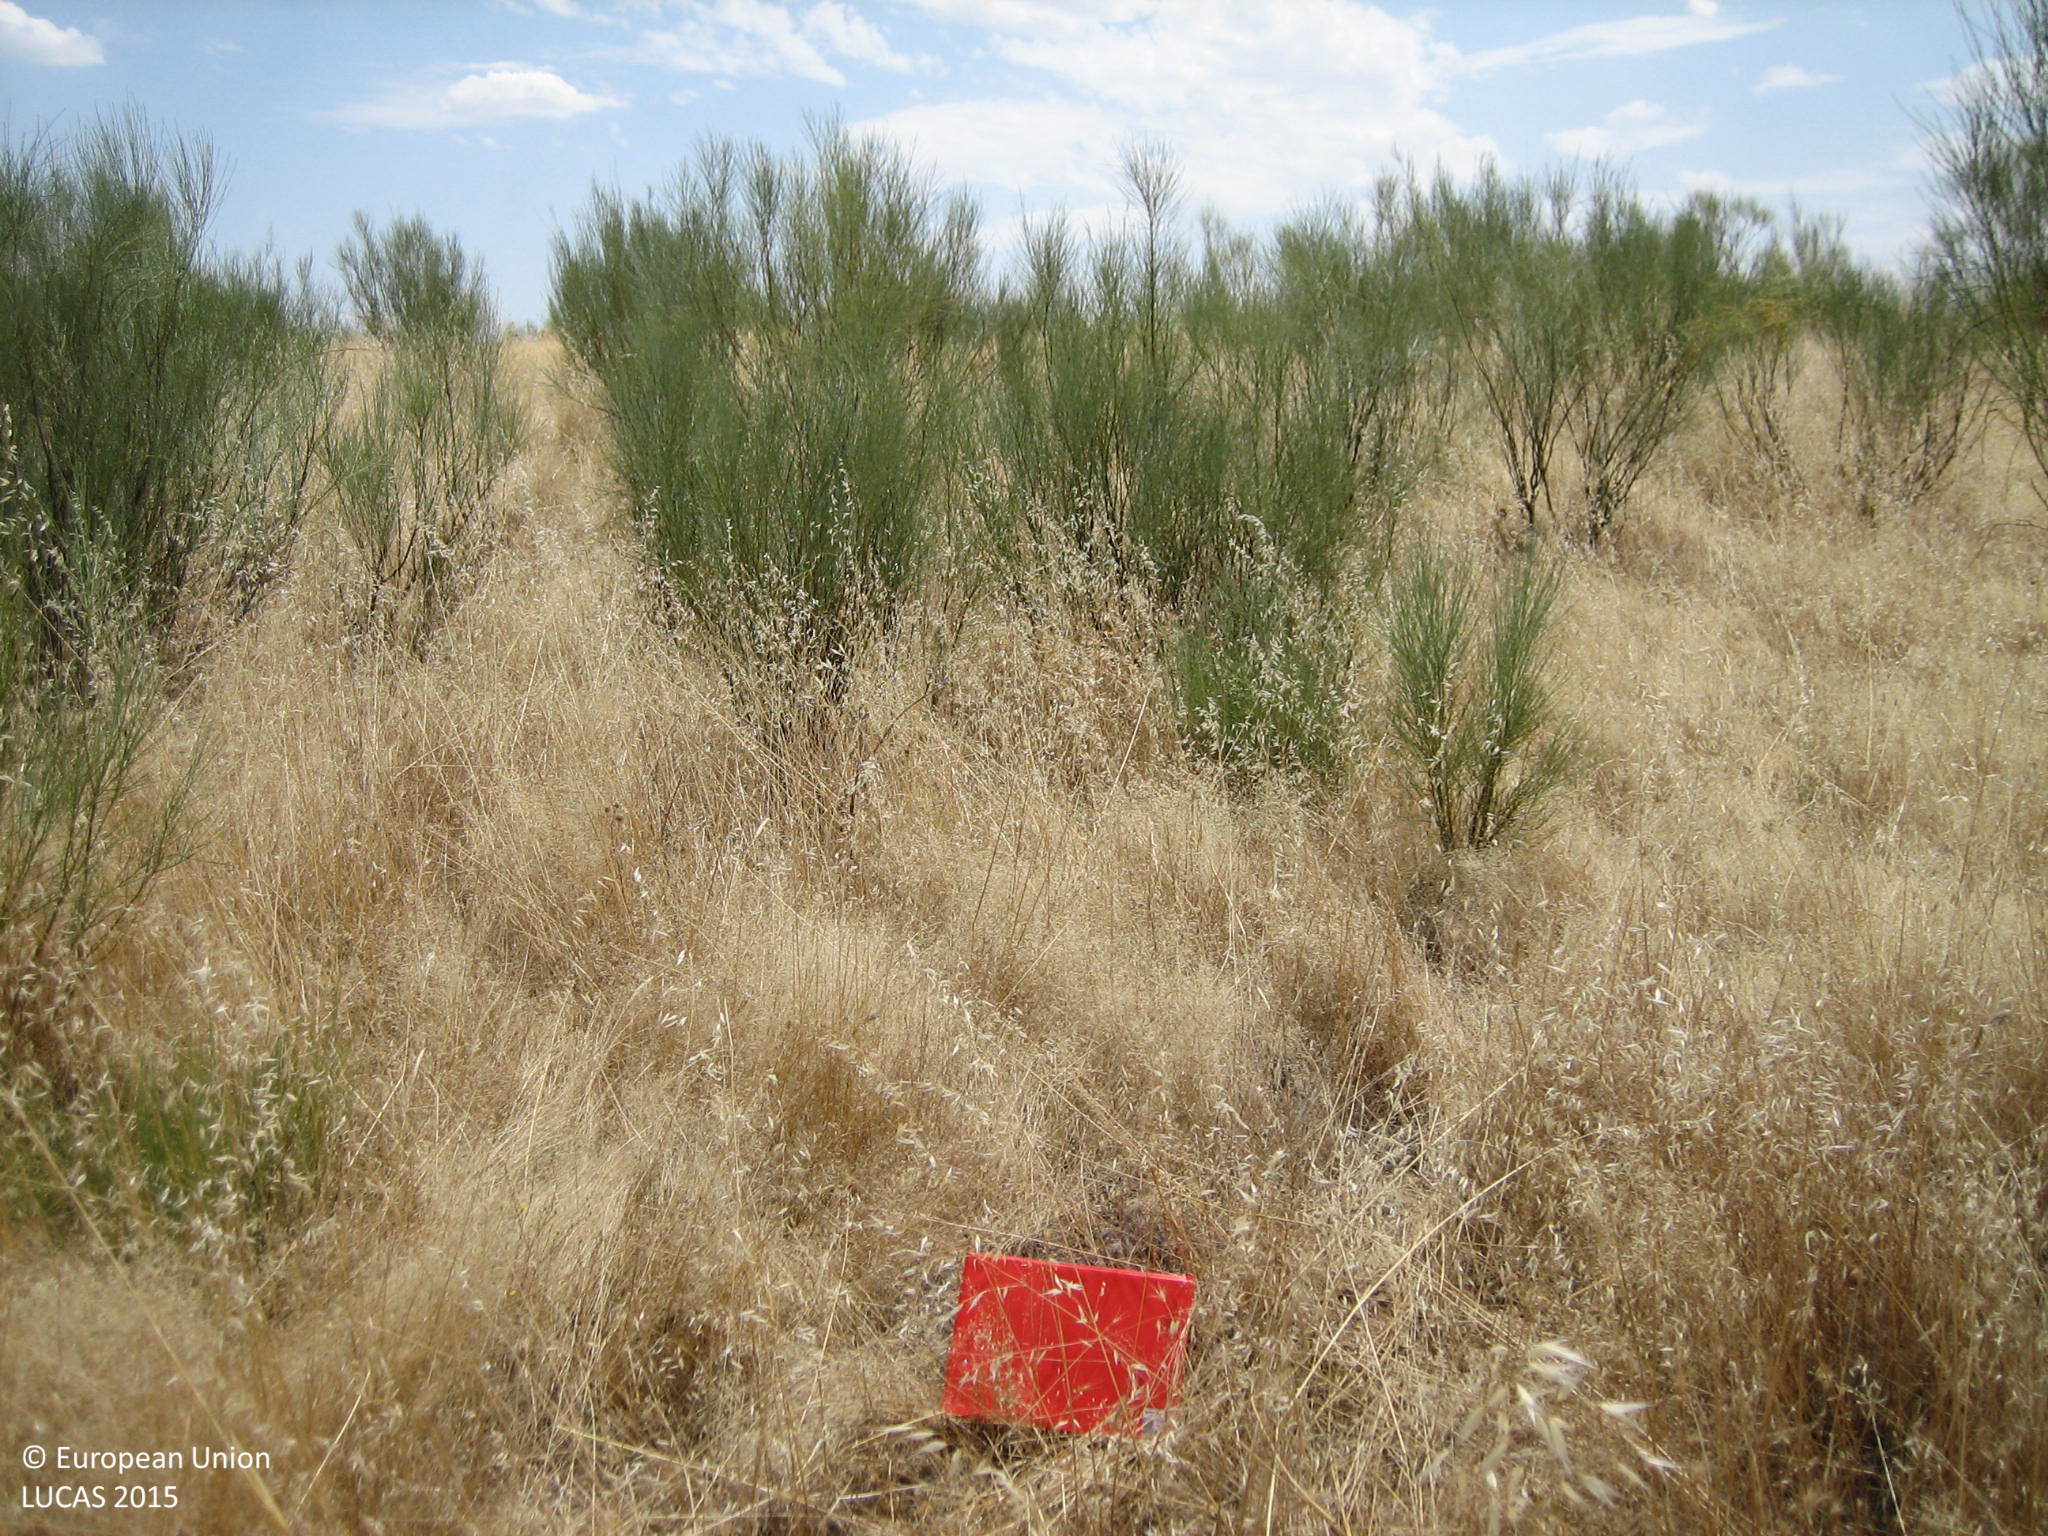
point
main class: Shrubland
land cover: Shrubland without tree cover
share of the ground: 25 - 50 %
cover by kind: herbaceous plants 70 %, shrubs 30 %
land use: Agriculture (excluding fallow land and kitchen gardens)
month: July
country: ES
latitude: 38.5366
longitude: -5.3490
